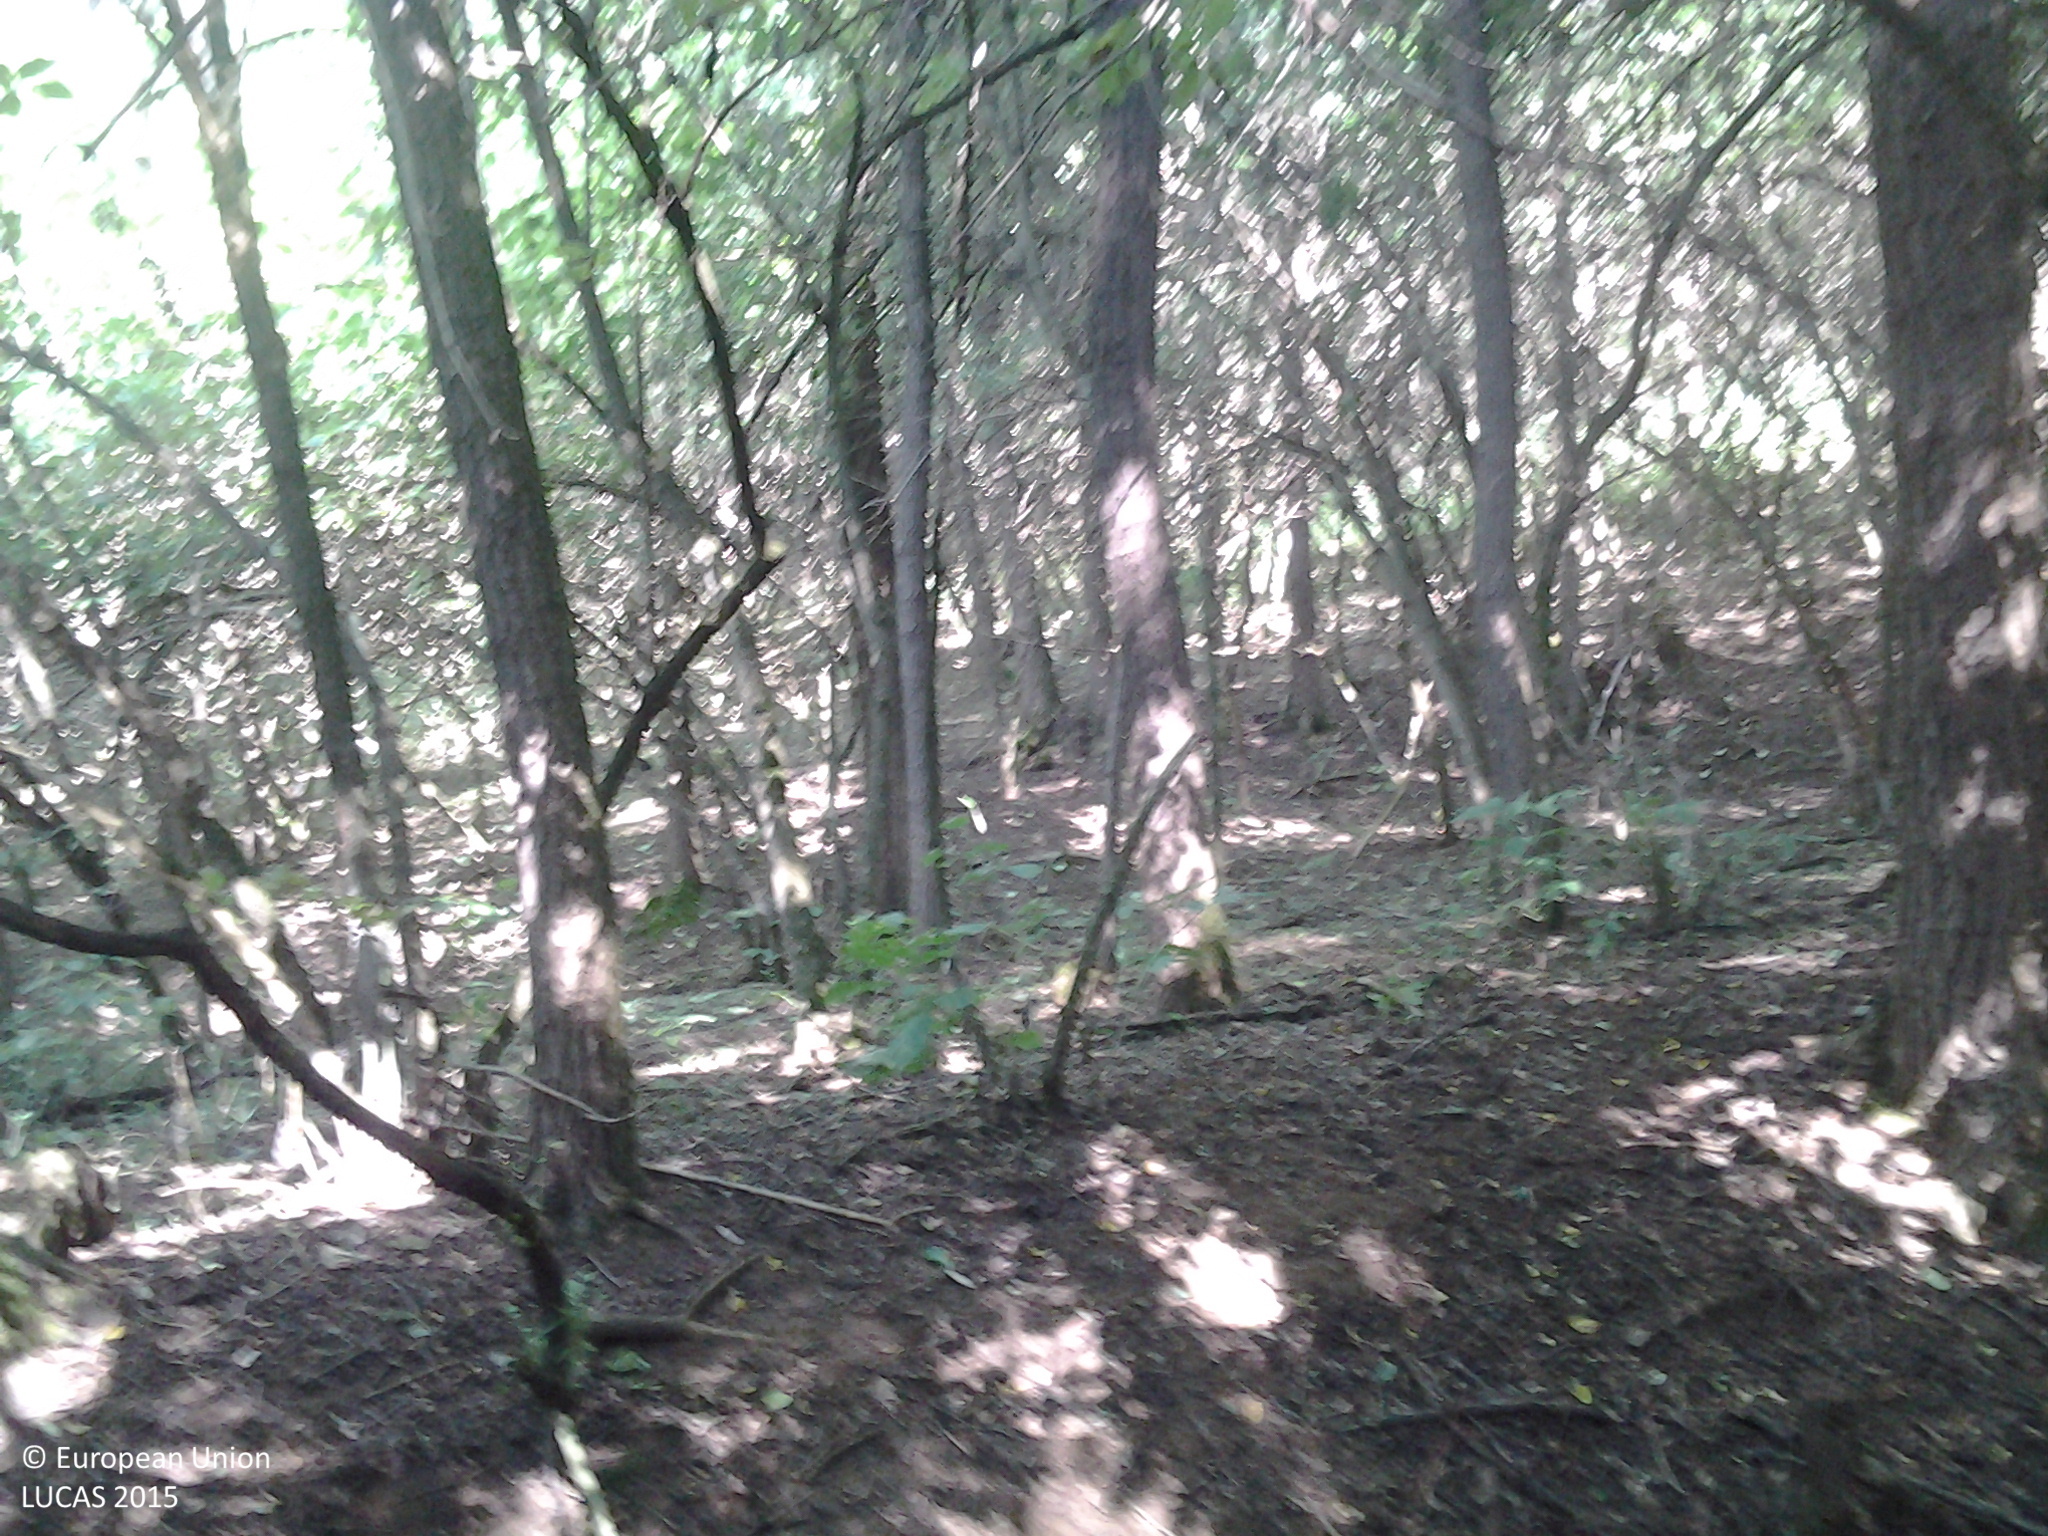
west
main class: Woodland
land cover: Broadleaved woodland
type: mesophytic deciduous forest
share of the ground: > 75 %
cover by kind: broadleaved forest trees 80 %, shrubs 20 %
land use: Forestry
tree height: > 5 m
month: August
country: HU
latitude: 48.0095
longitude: 19.9337
